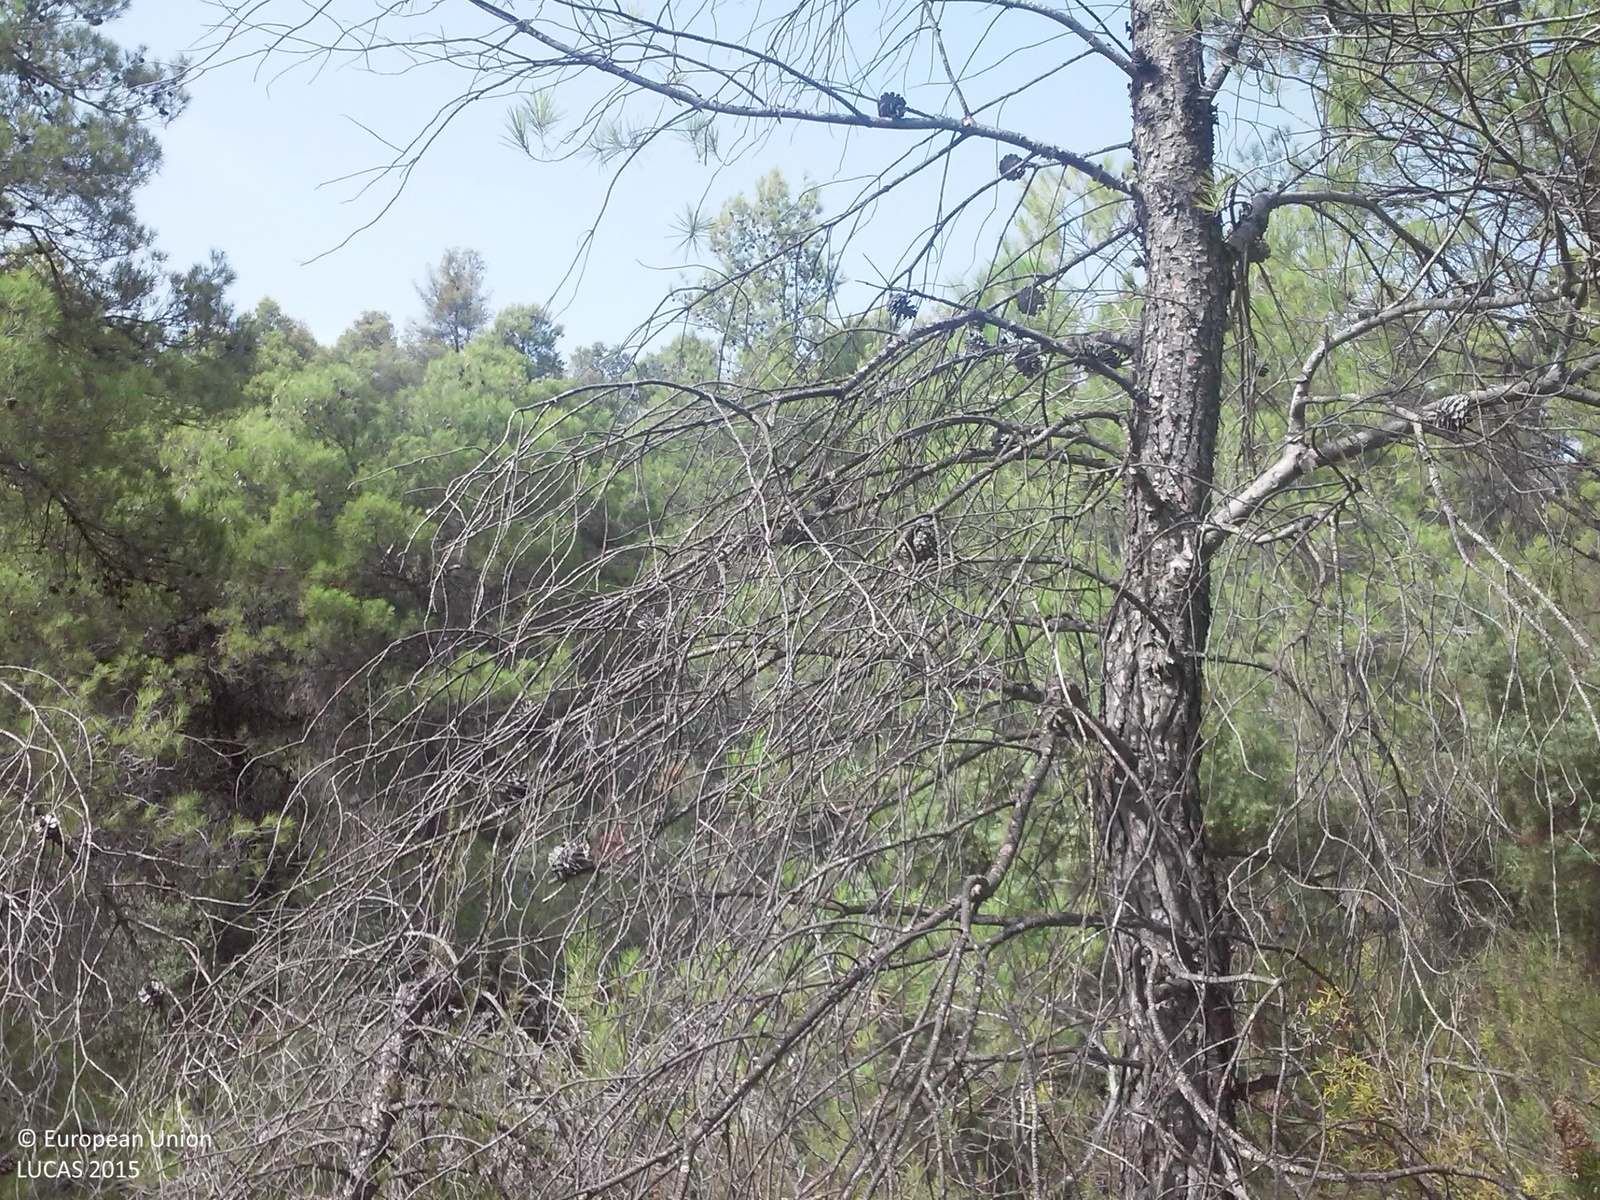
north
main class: Woodland
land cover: Pine dominated coniferous woodland
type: coniferous forest of the mediterranean region
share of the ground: 50 - 75 %
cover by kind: coniferous forest trees 30 %, shrubs 30 %, herbaceous plants 20 %, consolidated bare surface 15 %, broadleaved forest trees 5 %
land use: Semi-natural and natural areas not in use
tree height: > 5 m
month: August
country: ES
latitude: 41.0908
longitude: 0.8140
